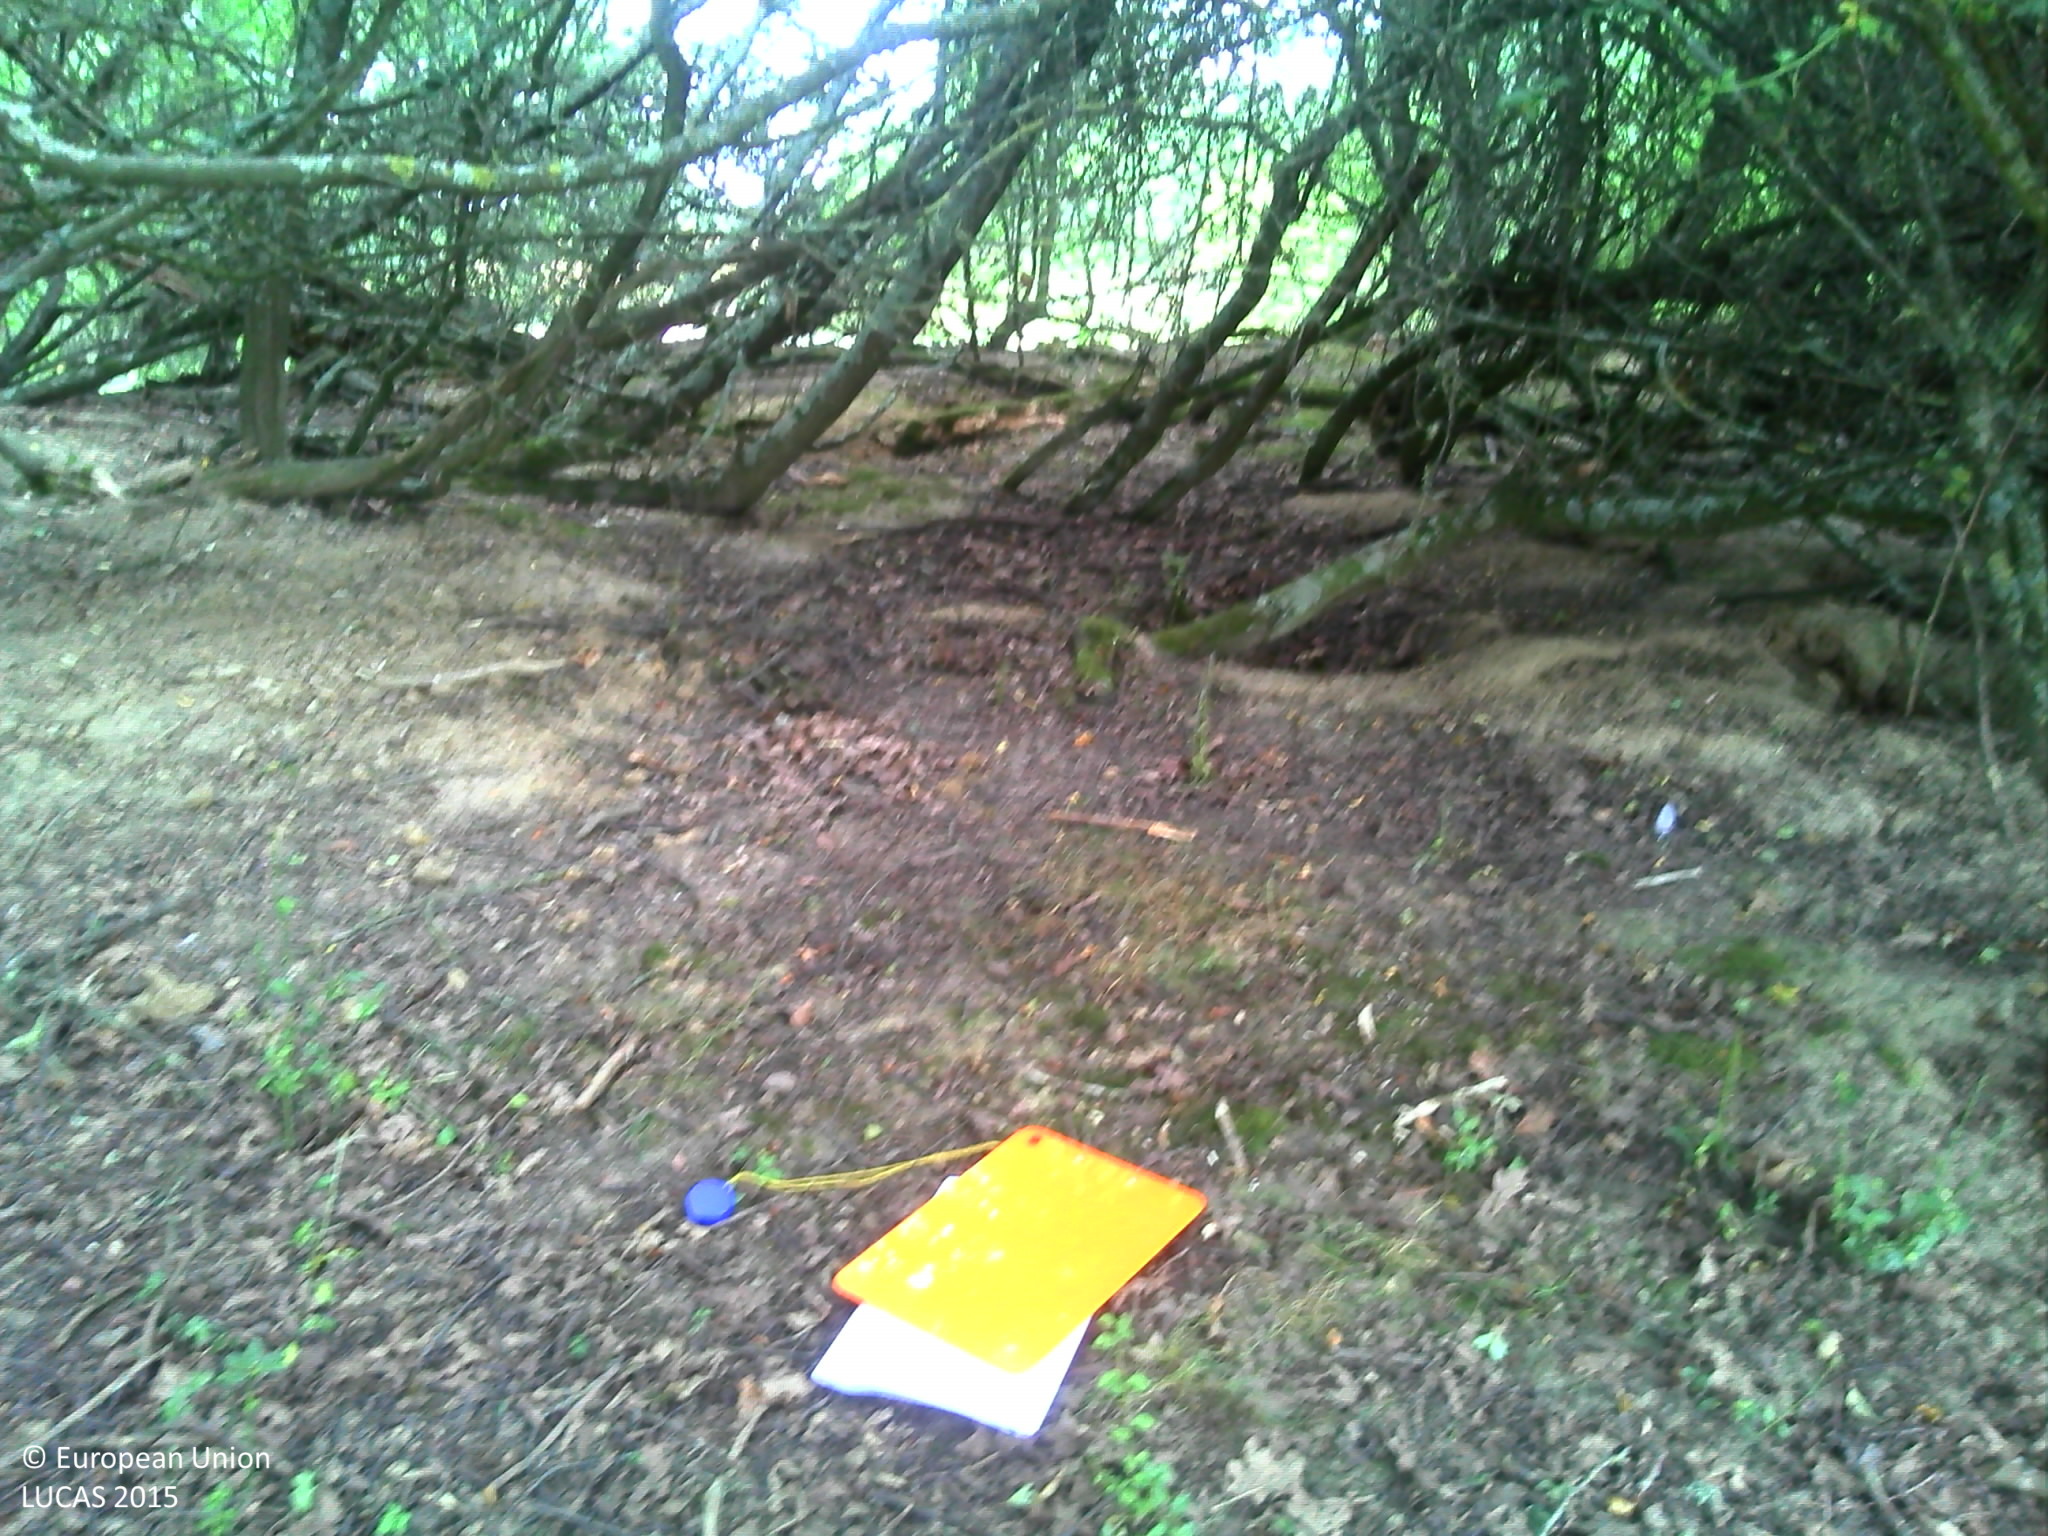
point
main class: Woodland
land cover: Broadleaved woodland
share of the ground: > 75 %
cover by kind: broadleaved forest trees 100 %
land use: Agriculture (excluding fallow land and kitchen gardens)
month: June
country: FR
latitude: 47.6102
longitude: 2.5555
